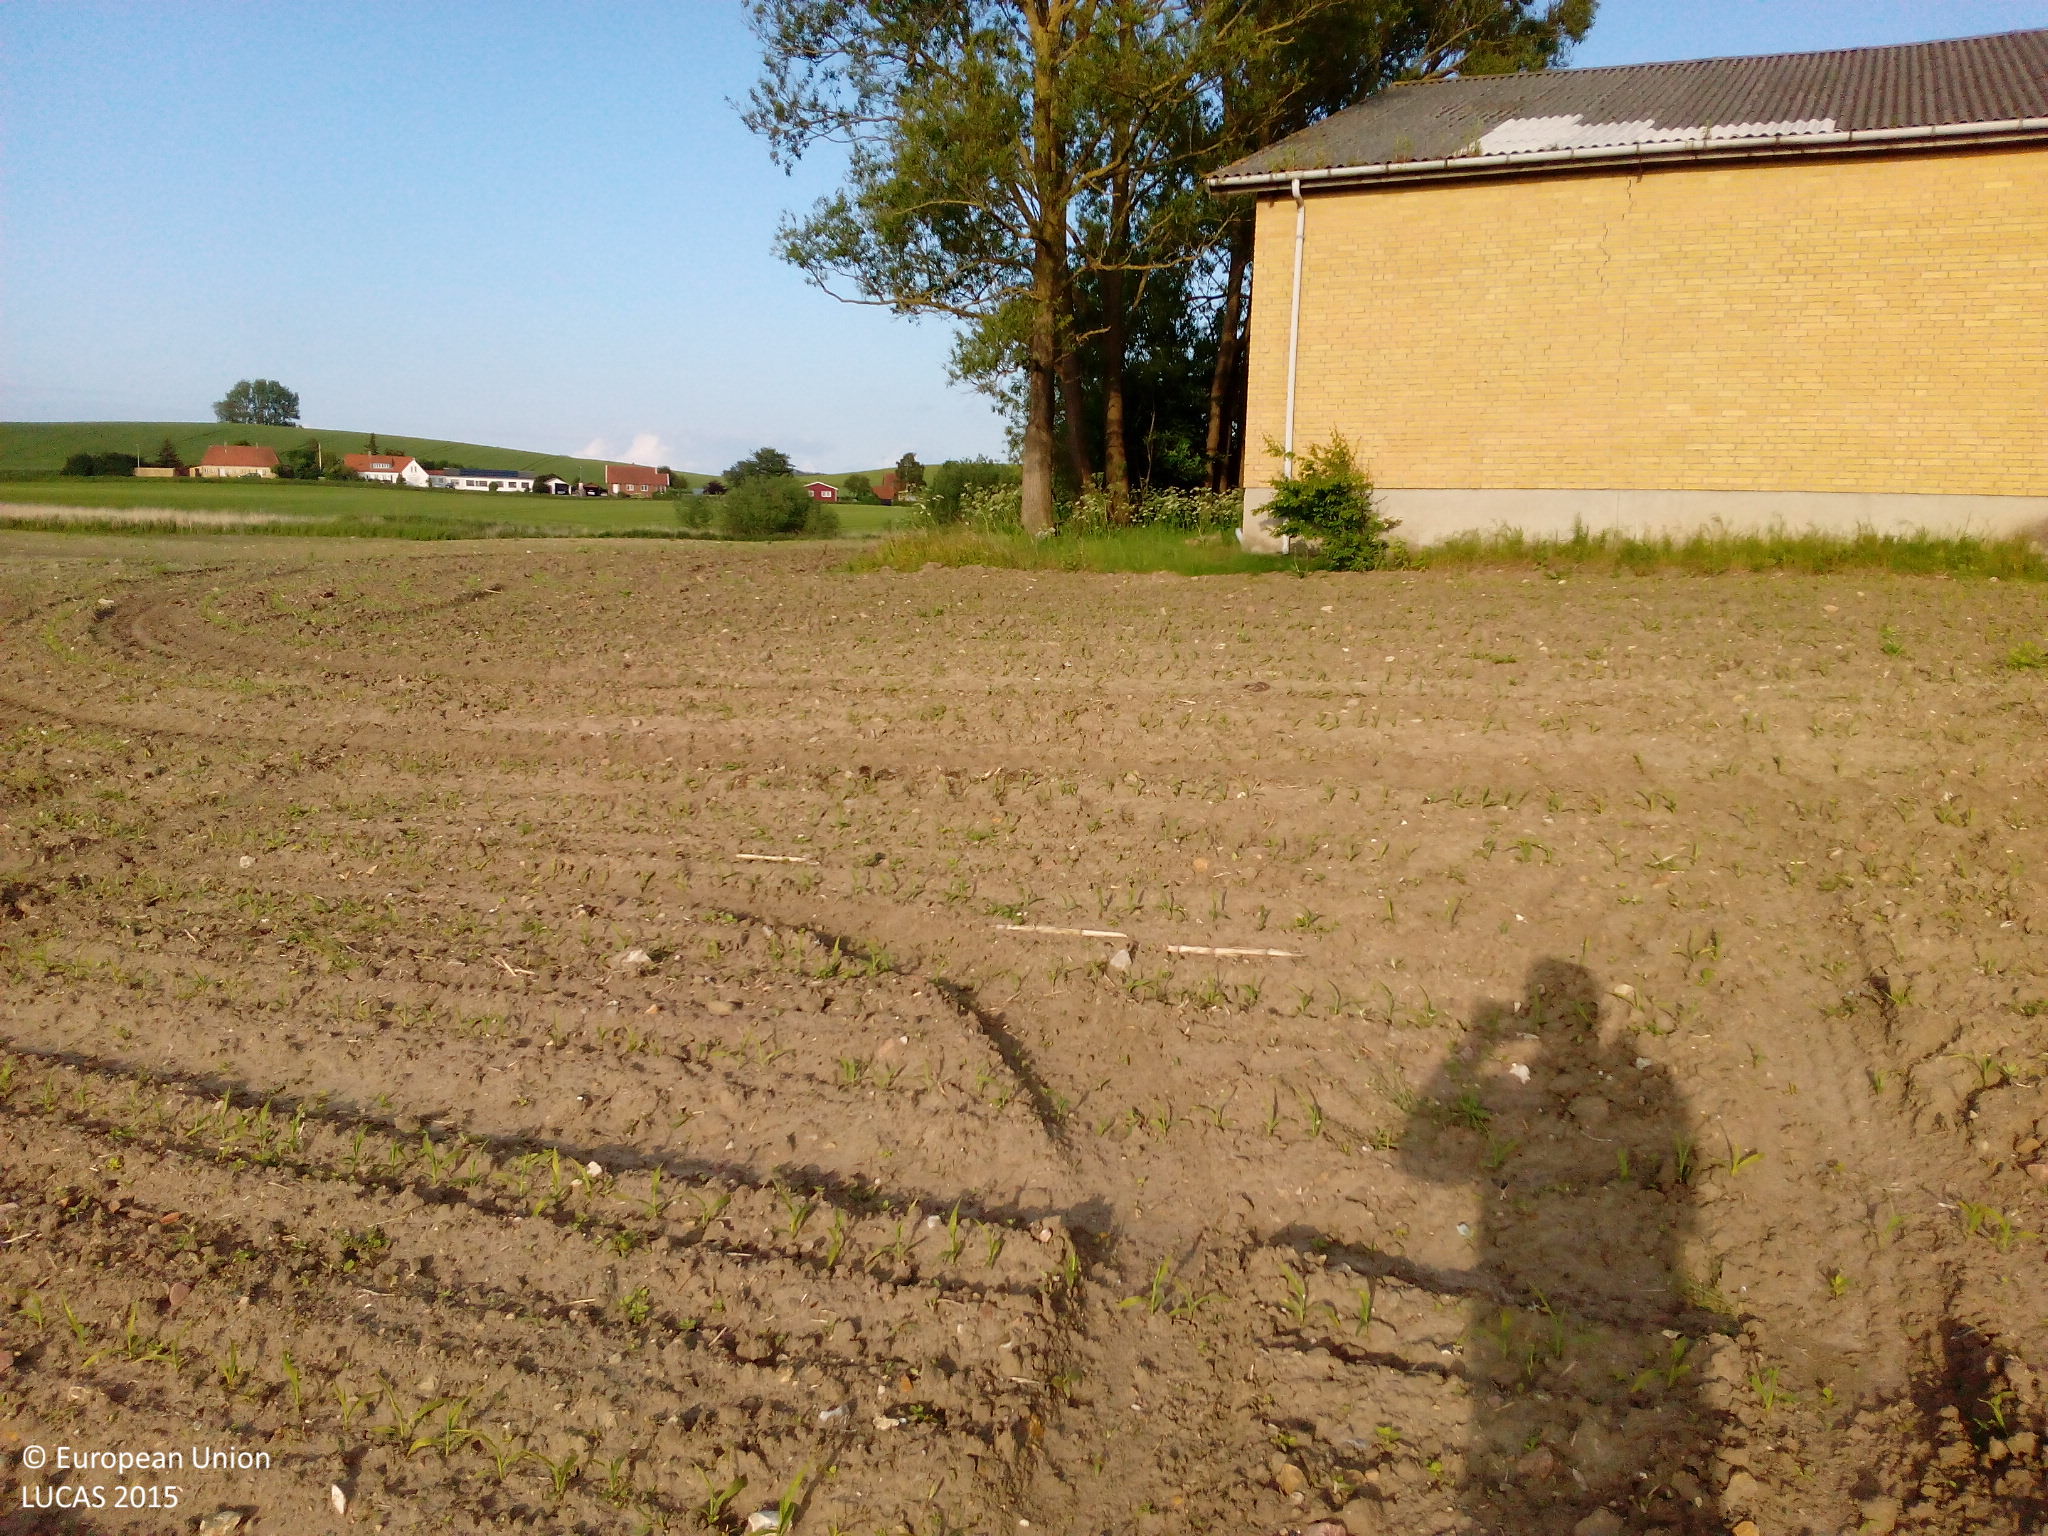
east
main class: Cropland
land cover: Maize
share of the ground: < 10 %
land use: Agriculture (excluding fallow land and kitchen gardens)
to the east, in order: Maize; Artificial constructions in urban areas; Maize; Spontaneously vegetated surfaces; Temporary grasslands
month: June
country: DK
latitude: 55.5210
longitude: 10.6488
